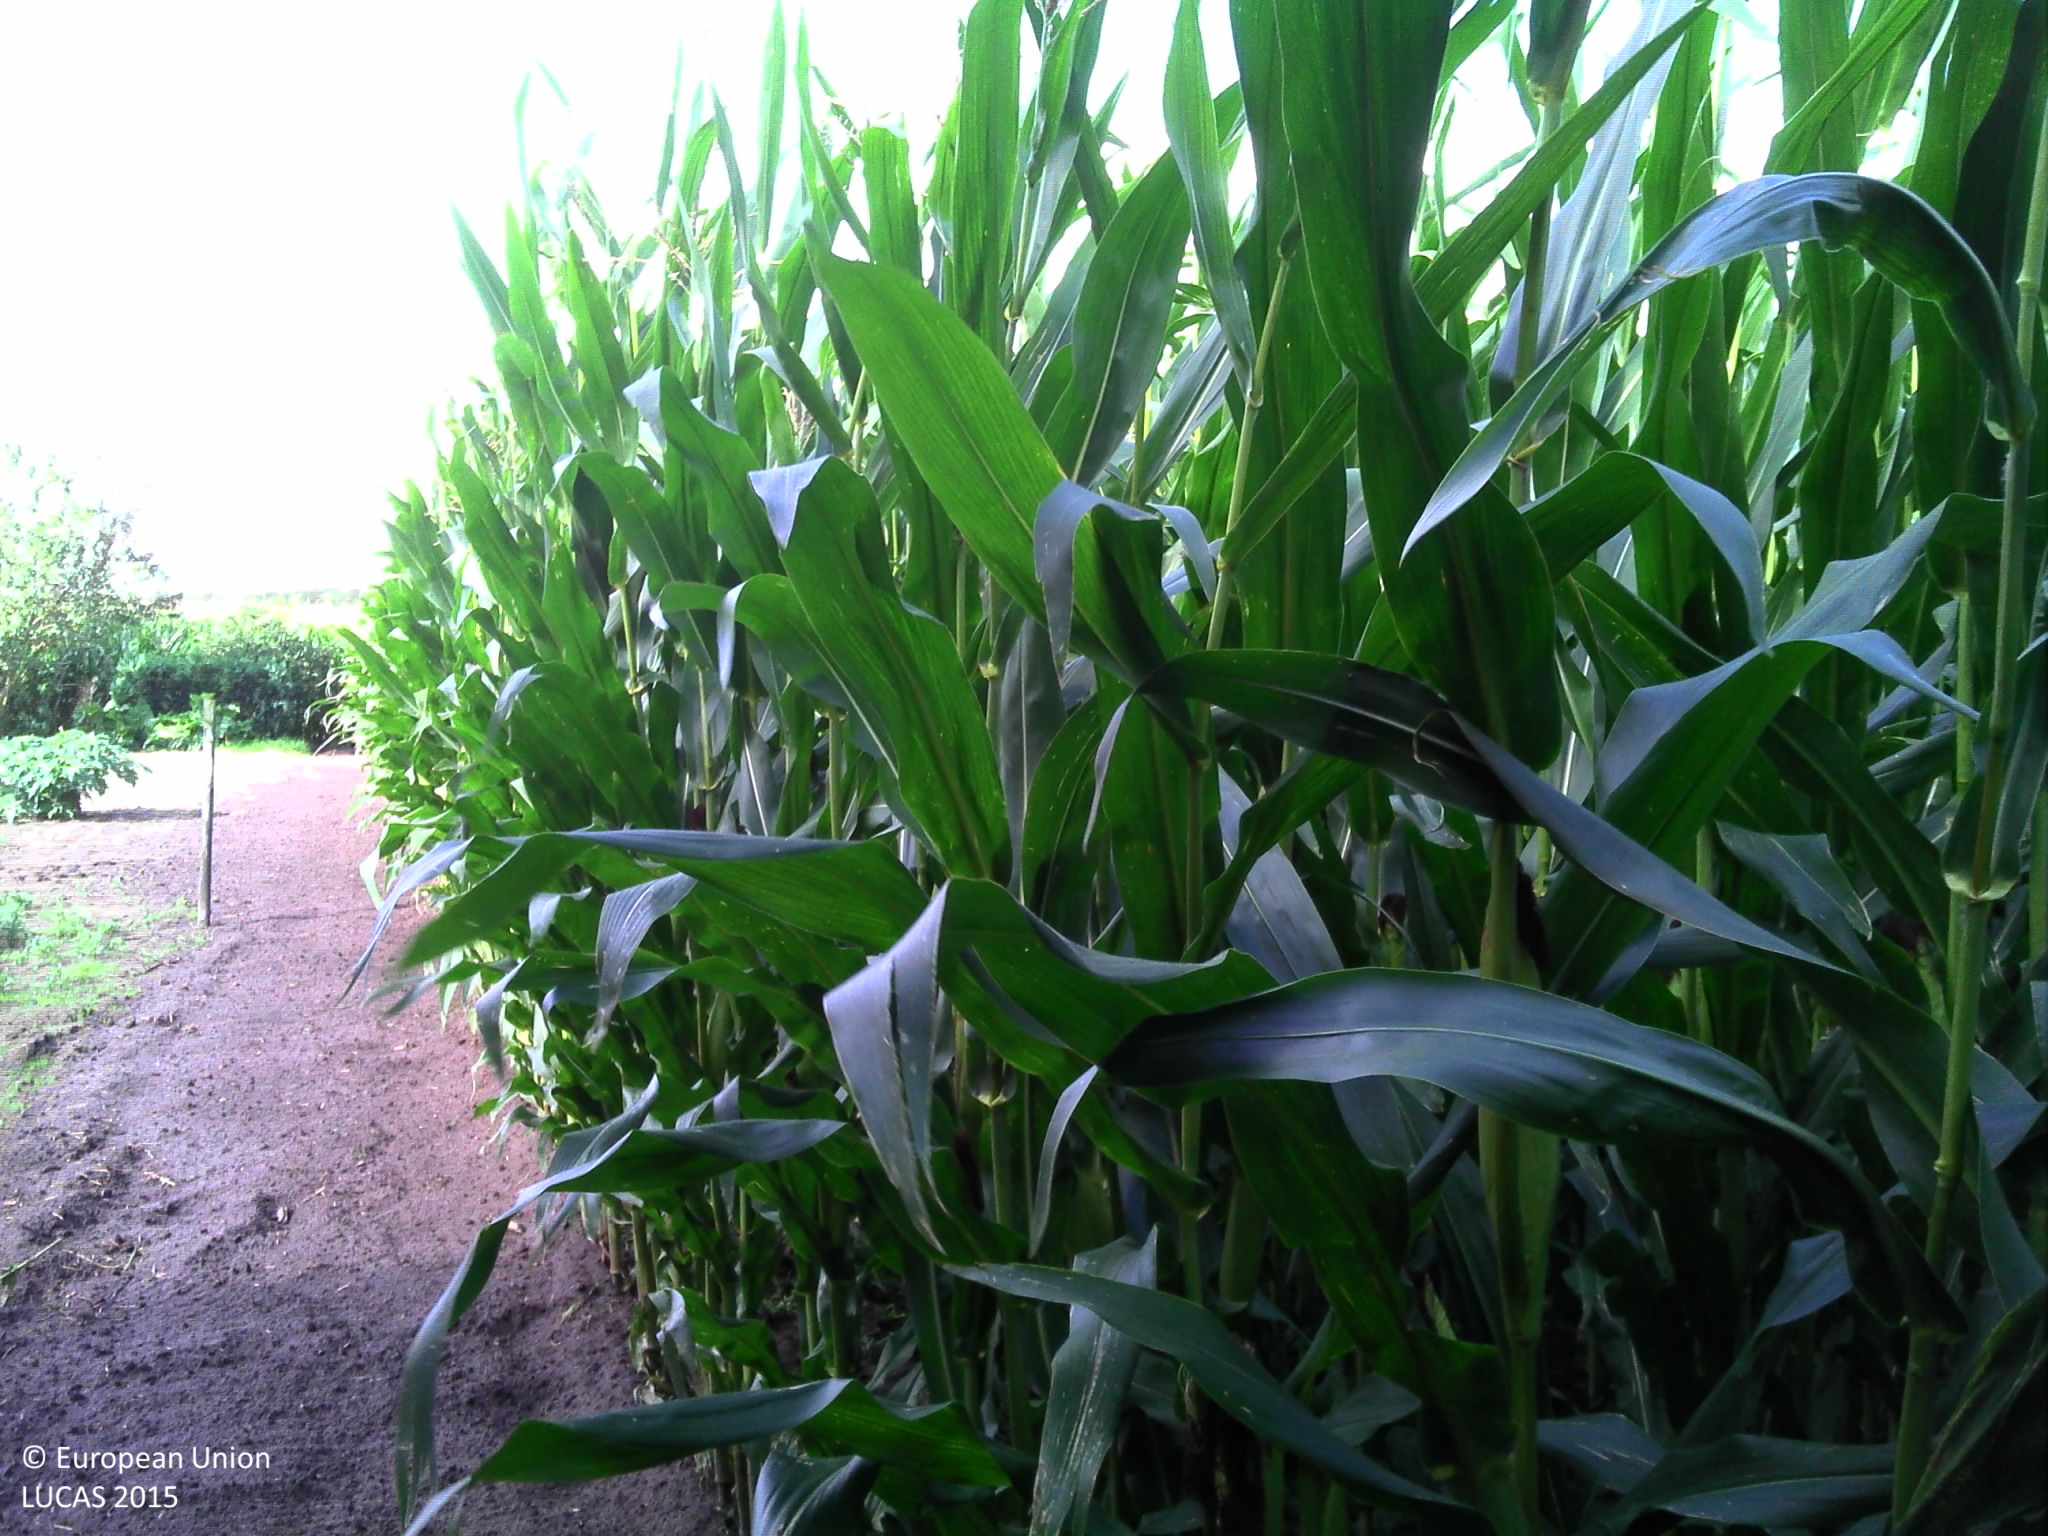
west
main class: Cropland
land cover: Maize
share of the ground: > 75 %
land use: Agriculture (excluding fallow land and kitchen gardens)
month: September
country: BE
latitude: 51.4206
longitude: 4.4880
